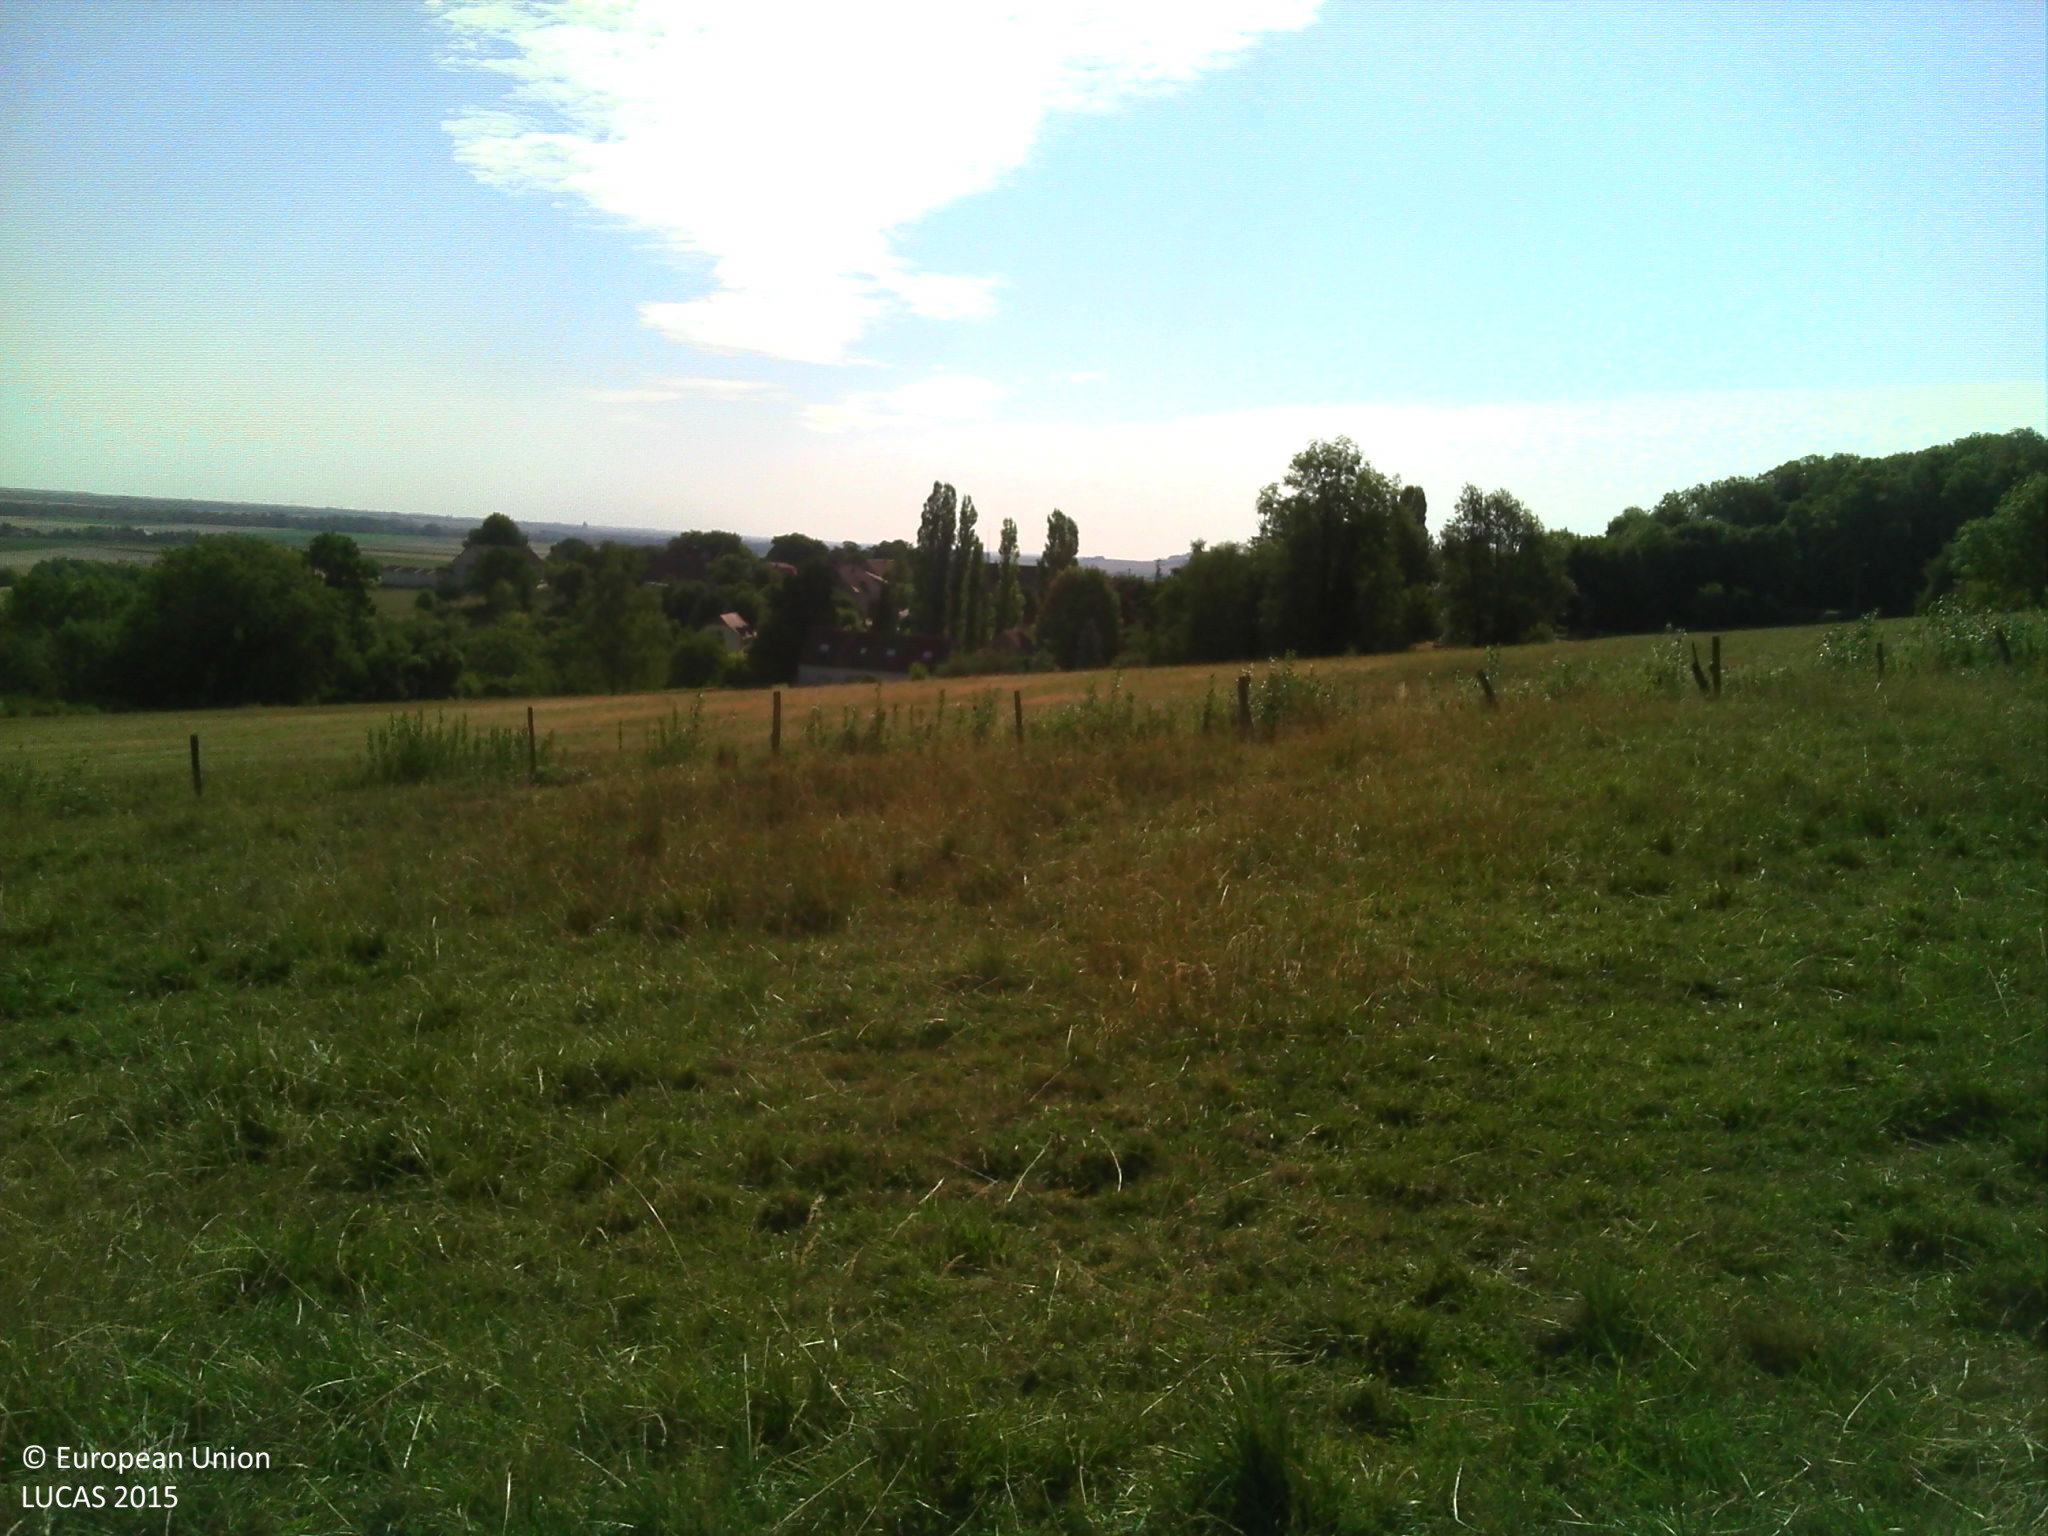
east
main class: Grassland
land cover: Grassland without tree/shrub cover
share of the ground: > 75 %
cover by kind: herbaceous plants 85 %, unconsolidated bare surface 10 %
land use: Agriculture (excluding fallow land and kitchen gardens)
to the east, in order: Grassland without tree/shrub cover; Fences; Ditches and canals; Grassland without tree/shrub cover; Fences; Grassland with sparse tree/shrub cover; Artificial constructions in urban areas; Fences; Grass margins
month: August
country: FR
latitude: 48.7874
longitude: 3.7744
